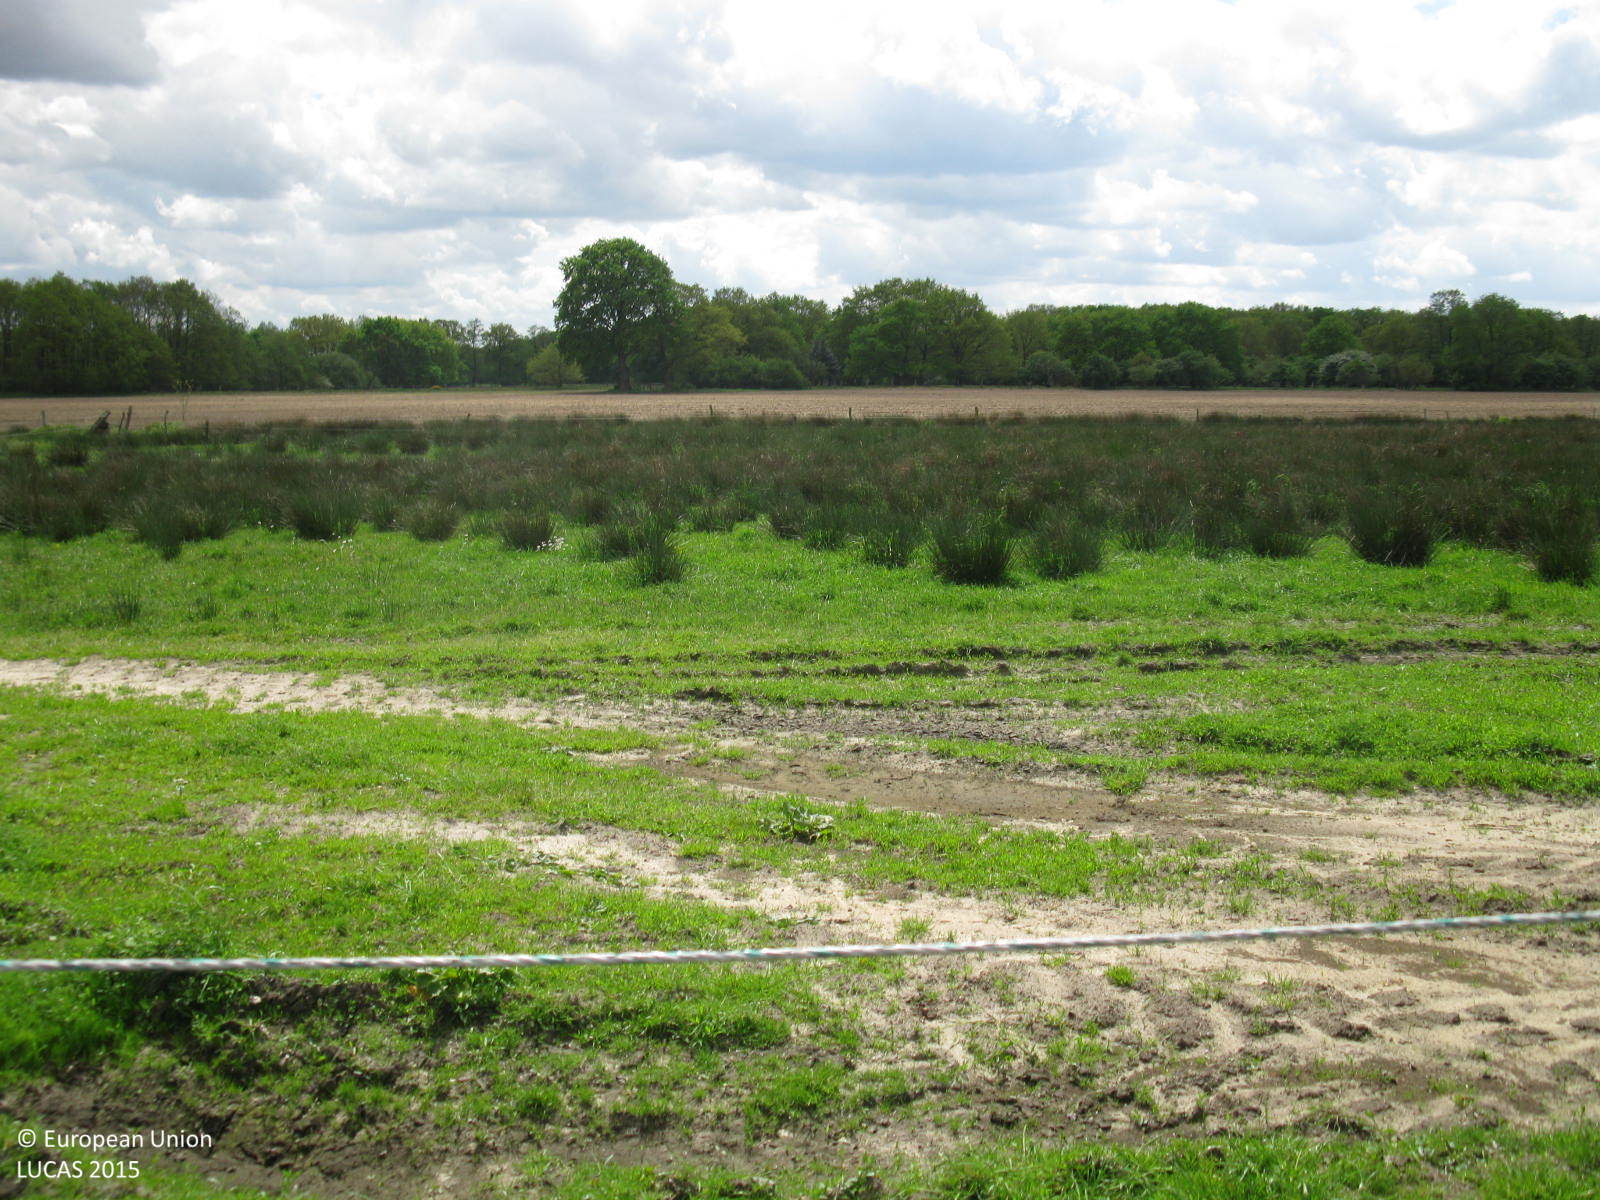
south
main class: Cropland
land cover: Triticale
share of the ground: > 75 %
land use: Agriculture (excluding fallow land and kitchen gardens)
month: May
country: DE
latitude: 52.9763
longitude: 7.3049
